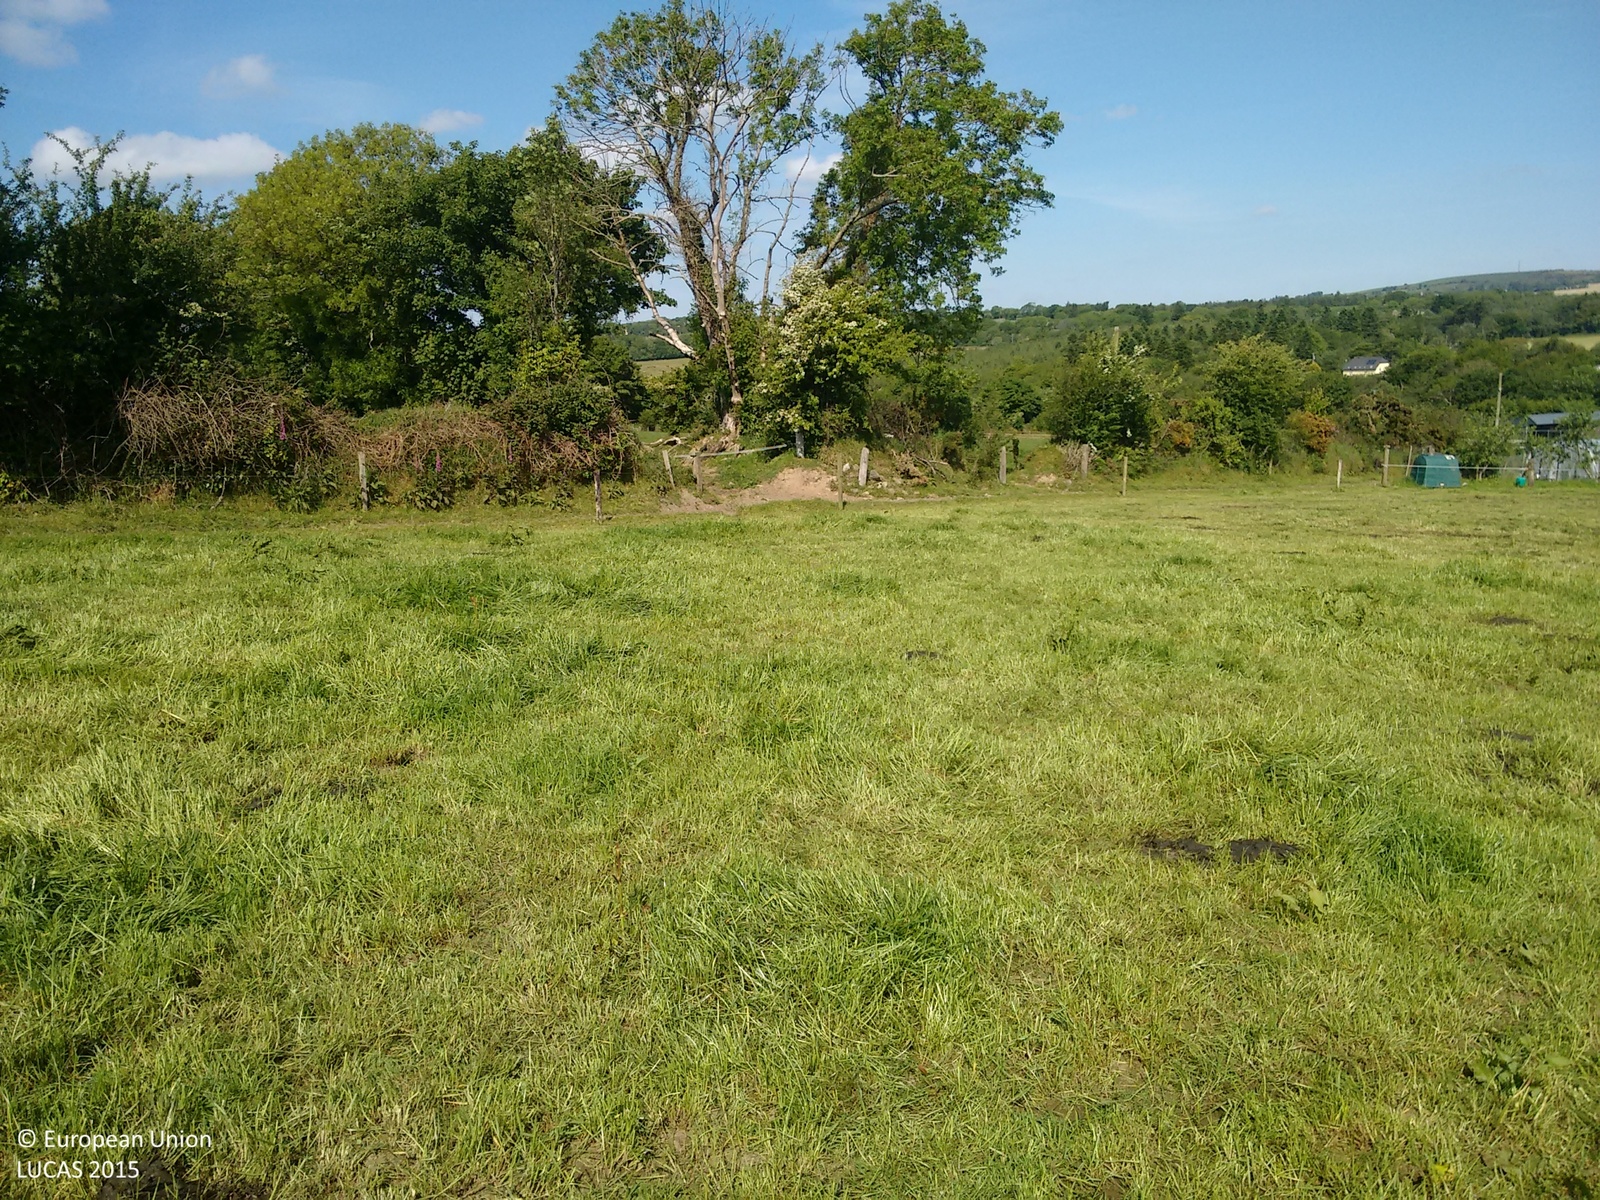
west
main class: Grassland
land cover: Grassland without tree/shrub cover
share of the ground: > 75 %
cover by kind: herbaceous plants 100 %
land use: Agriculture (excluding fallow land and kitchen gardens)
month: June
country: IE
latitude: 51.7837
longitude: -8.7735
